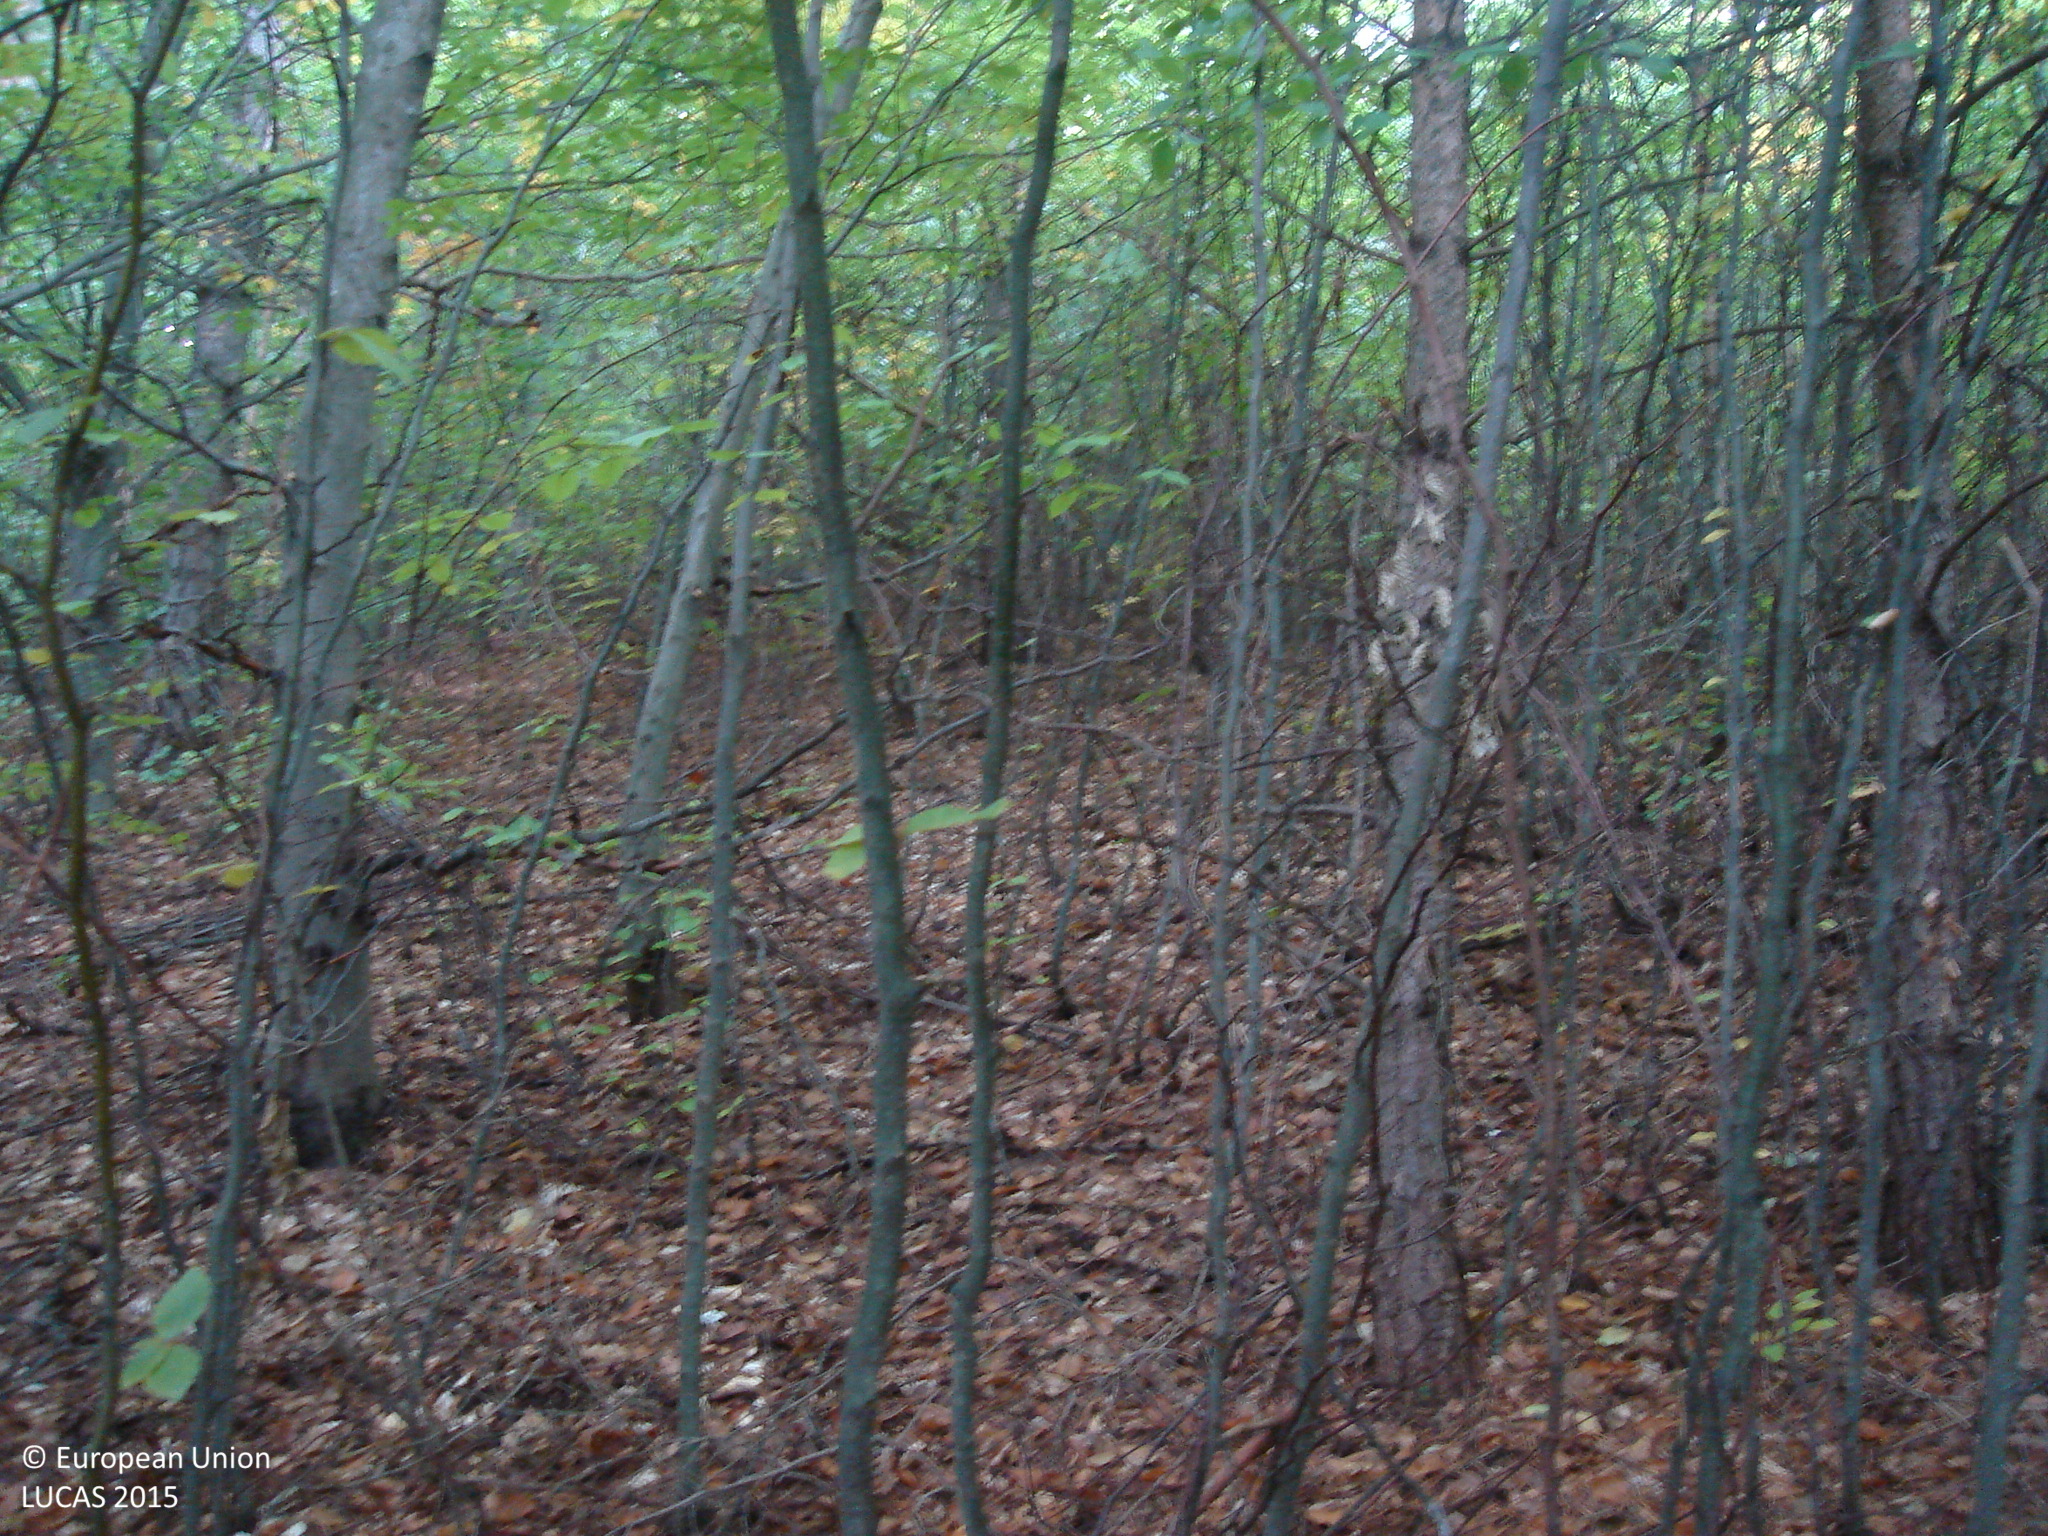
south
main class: Woodland
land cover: Spruce dominated mixed woodland
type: hemiboreal forest and nemoral coniferous forest and mixed broadleaved-coniferous forest
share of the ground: > 75 %
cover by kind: coniferous forest trees 50 %, broadleaved forest trees 40 %, unconsolidated bare surface 10 %
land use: Forestry
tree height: > 5 m
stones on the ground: < 10 %
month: October
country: BG
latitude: 42.9991
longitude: 23.4215
